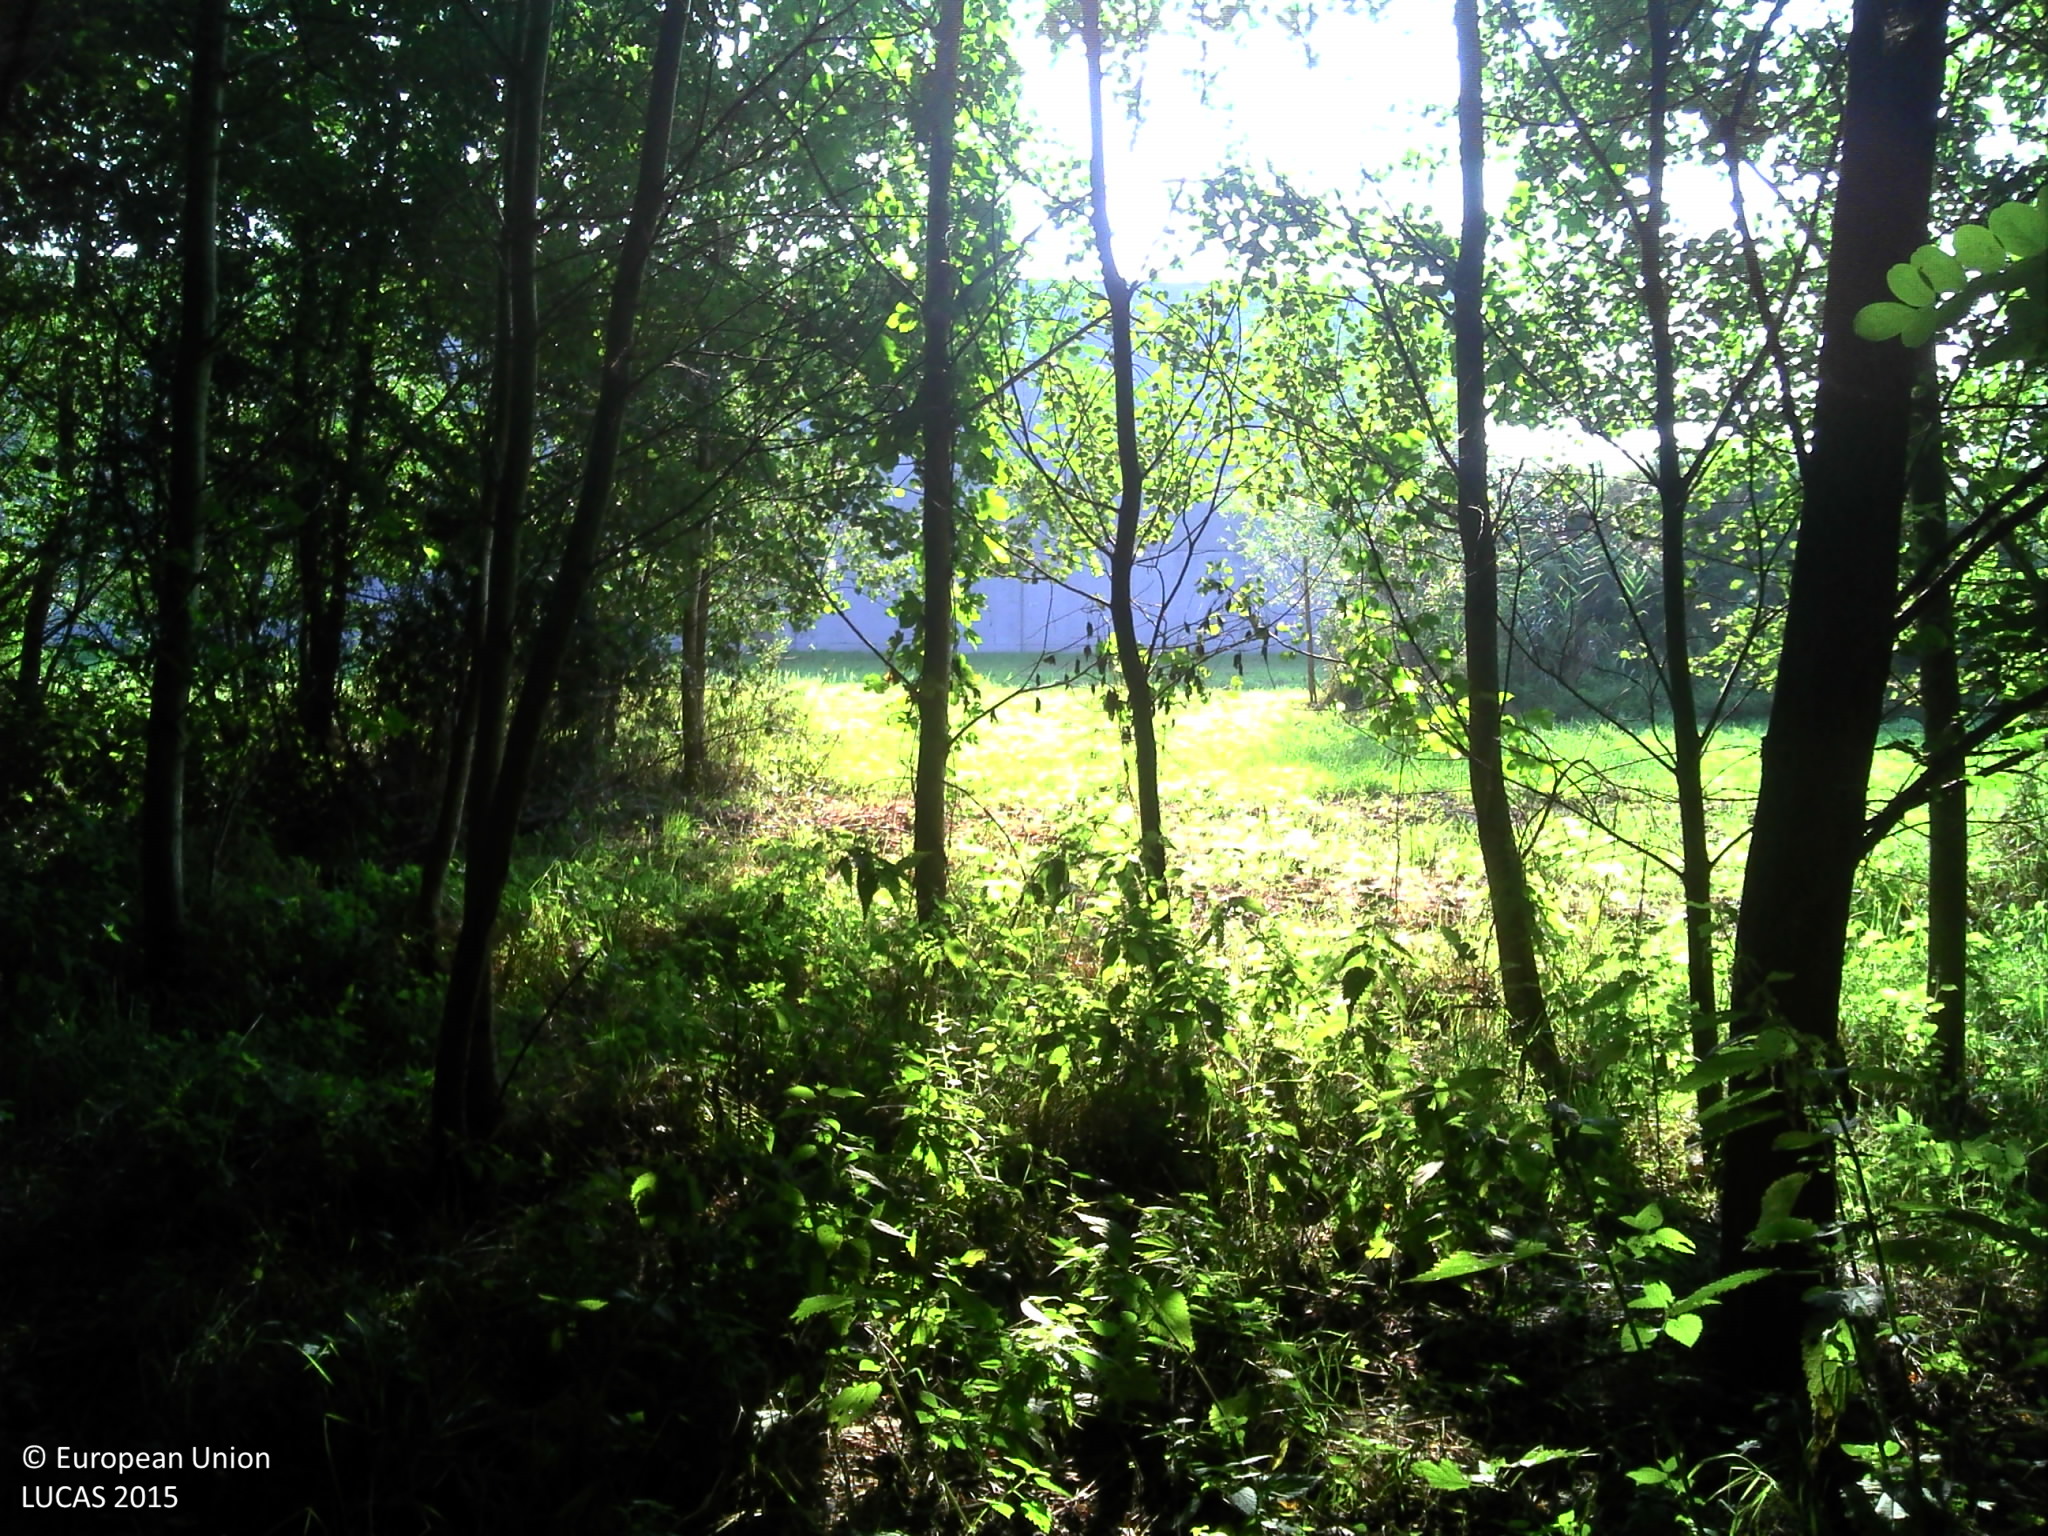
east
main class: Woodland
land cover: Broadleaved woodland
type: floodplain forest
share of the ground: > 75 %
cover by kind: broadleaved forest trees 100 %
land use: Forestry
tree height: > 5 m
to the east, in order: Broadleaved woodland; Spontaneously vegetated surfaces; Tracks; Spontaneously vegetated surfaces; Artificial constructions in urban areas
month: August
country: BE
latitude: 51.1619
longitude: 5.1498
